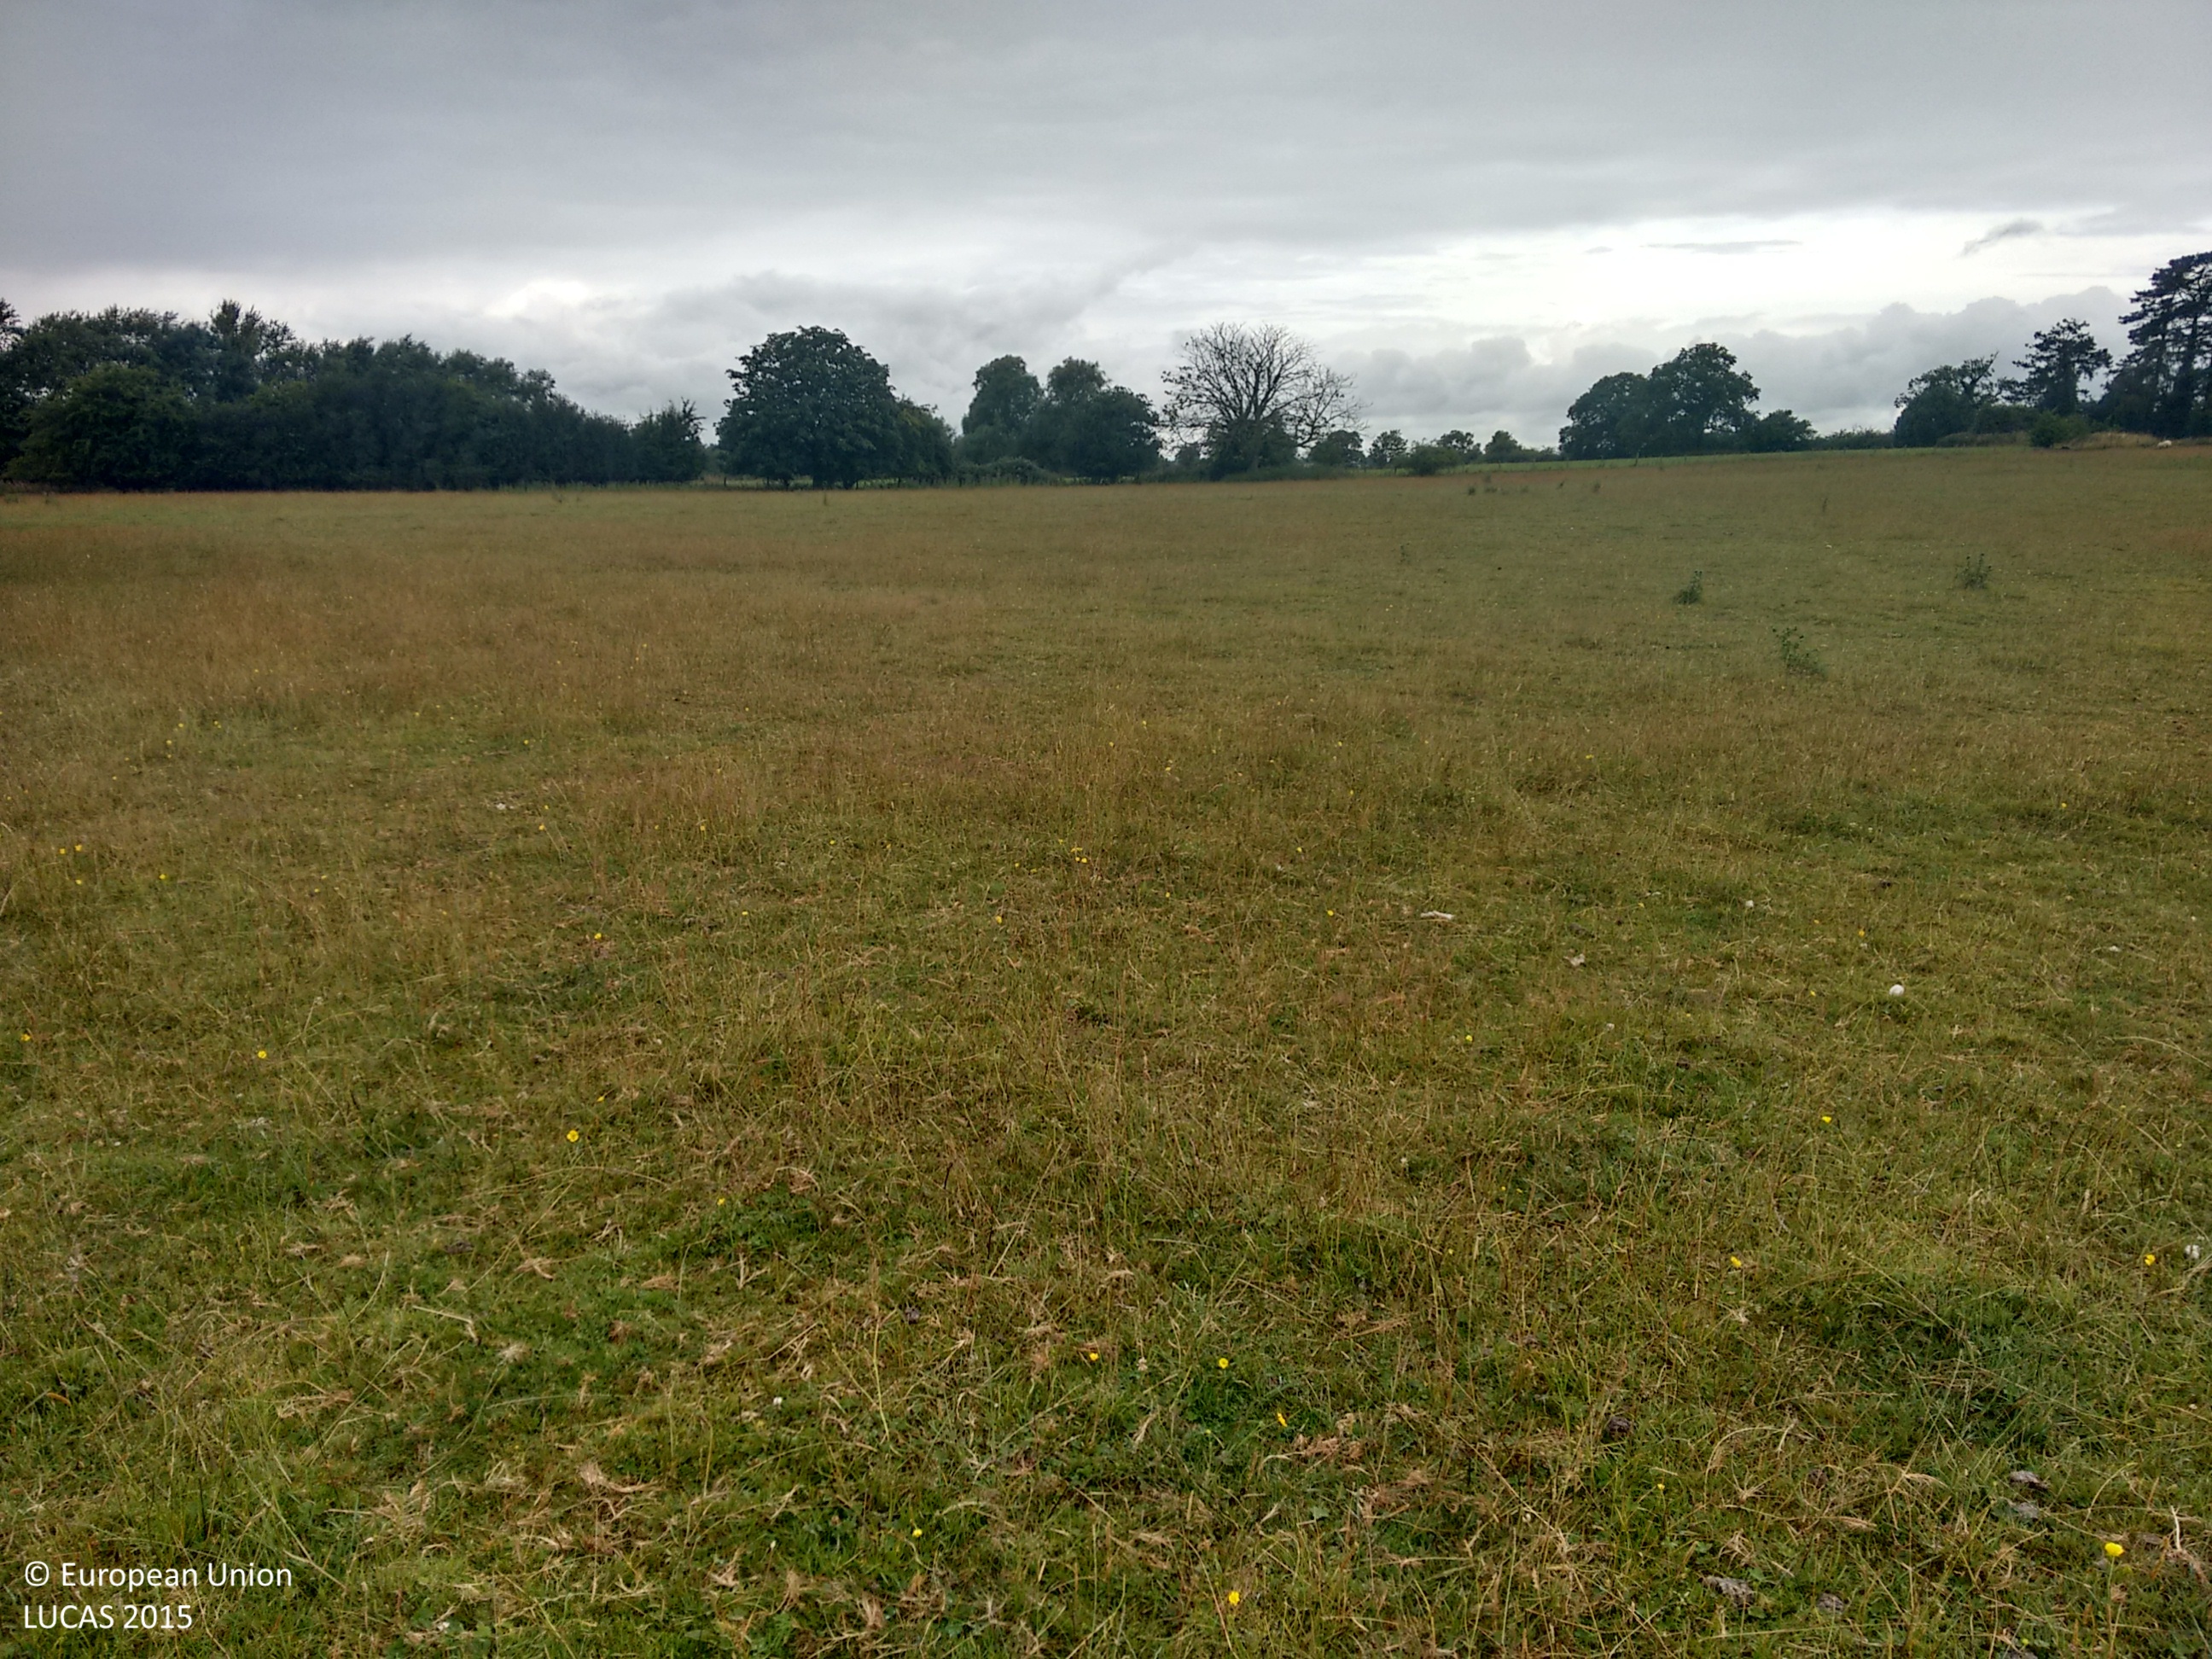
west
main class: Grassland
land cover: Grassland without tree/shrub cover
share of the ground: > 75 %
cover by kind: herbaceous plants 100 %
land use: Agriculture (excluding fallow land and kitchen gardens)
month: July
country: GB
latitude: 51.5460
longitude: -2.3646
